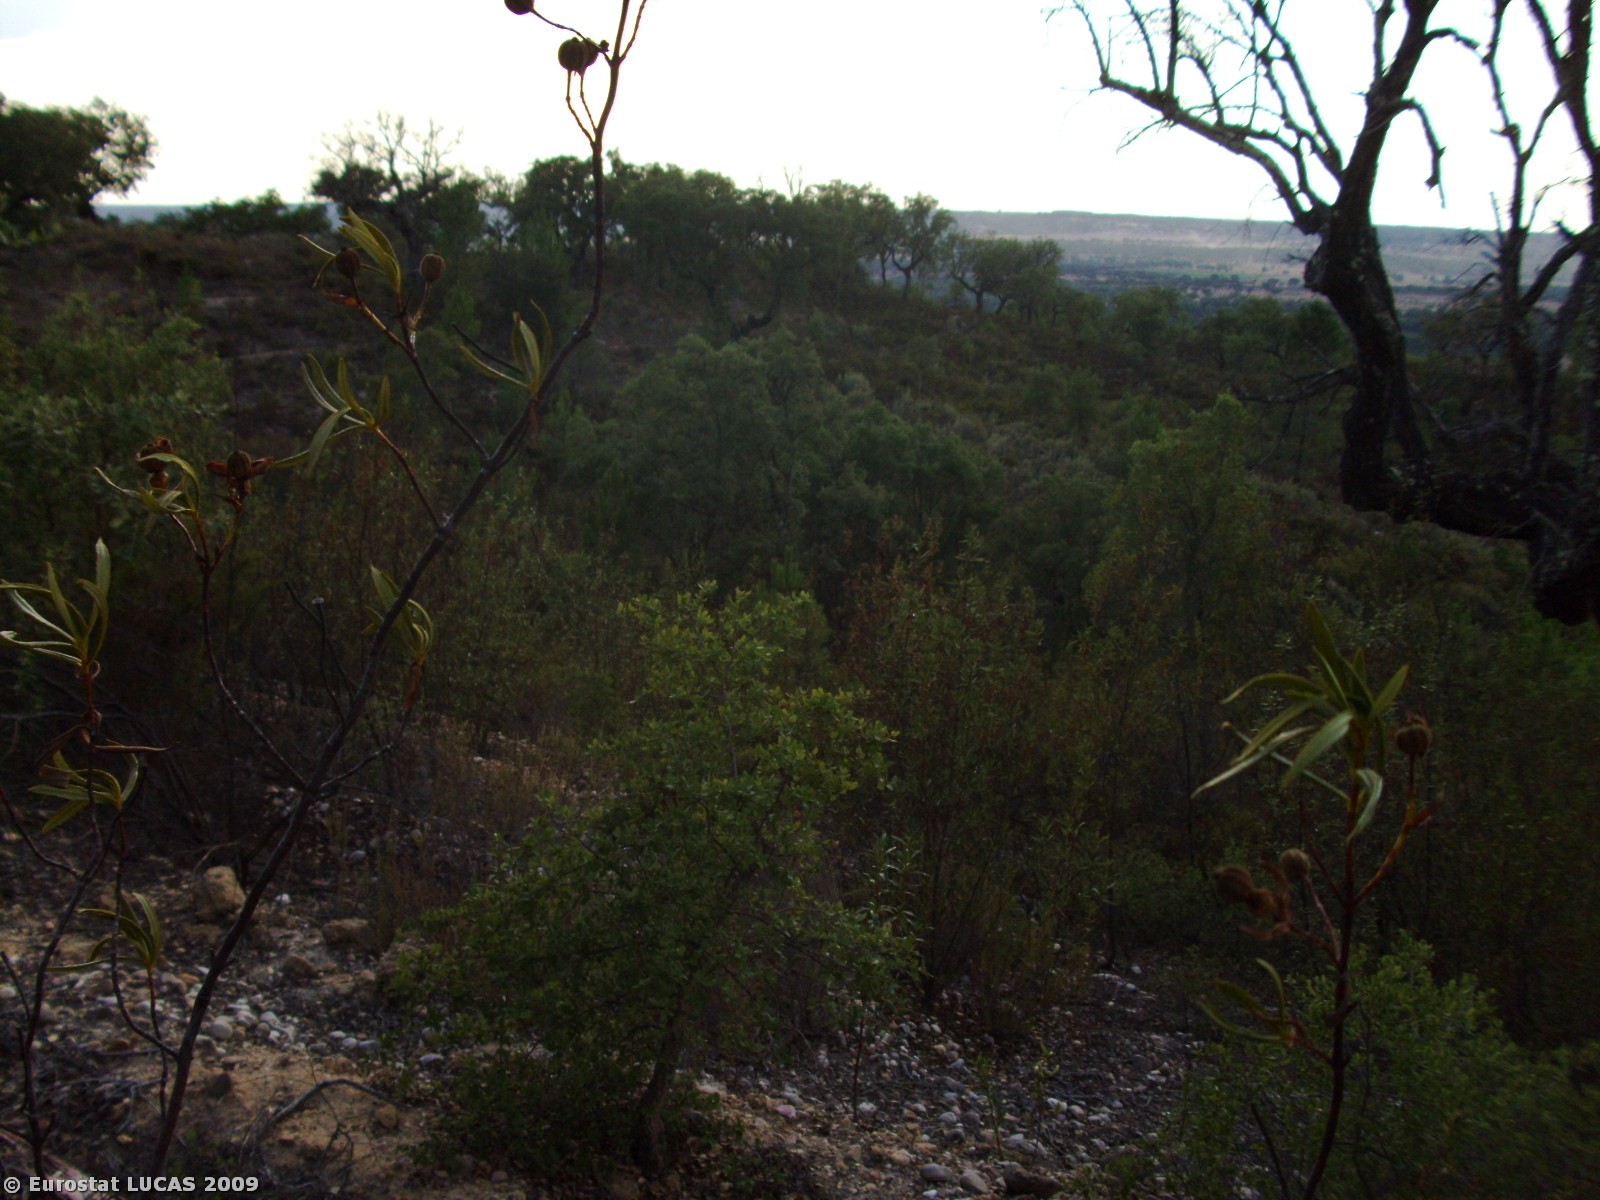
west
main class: Woodland
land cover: Broadleaved woodland
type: broadleaved evergreen forest
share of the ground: 25 - 50 %
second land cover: Shrubland with sparse tree cover
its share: 25 - 50 %
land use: Forestry
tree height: > 5 m
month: August
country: PT
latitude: 39.1904
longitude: -8.0347
